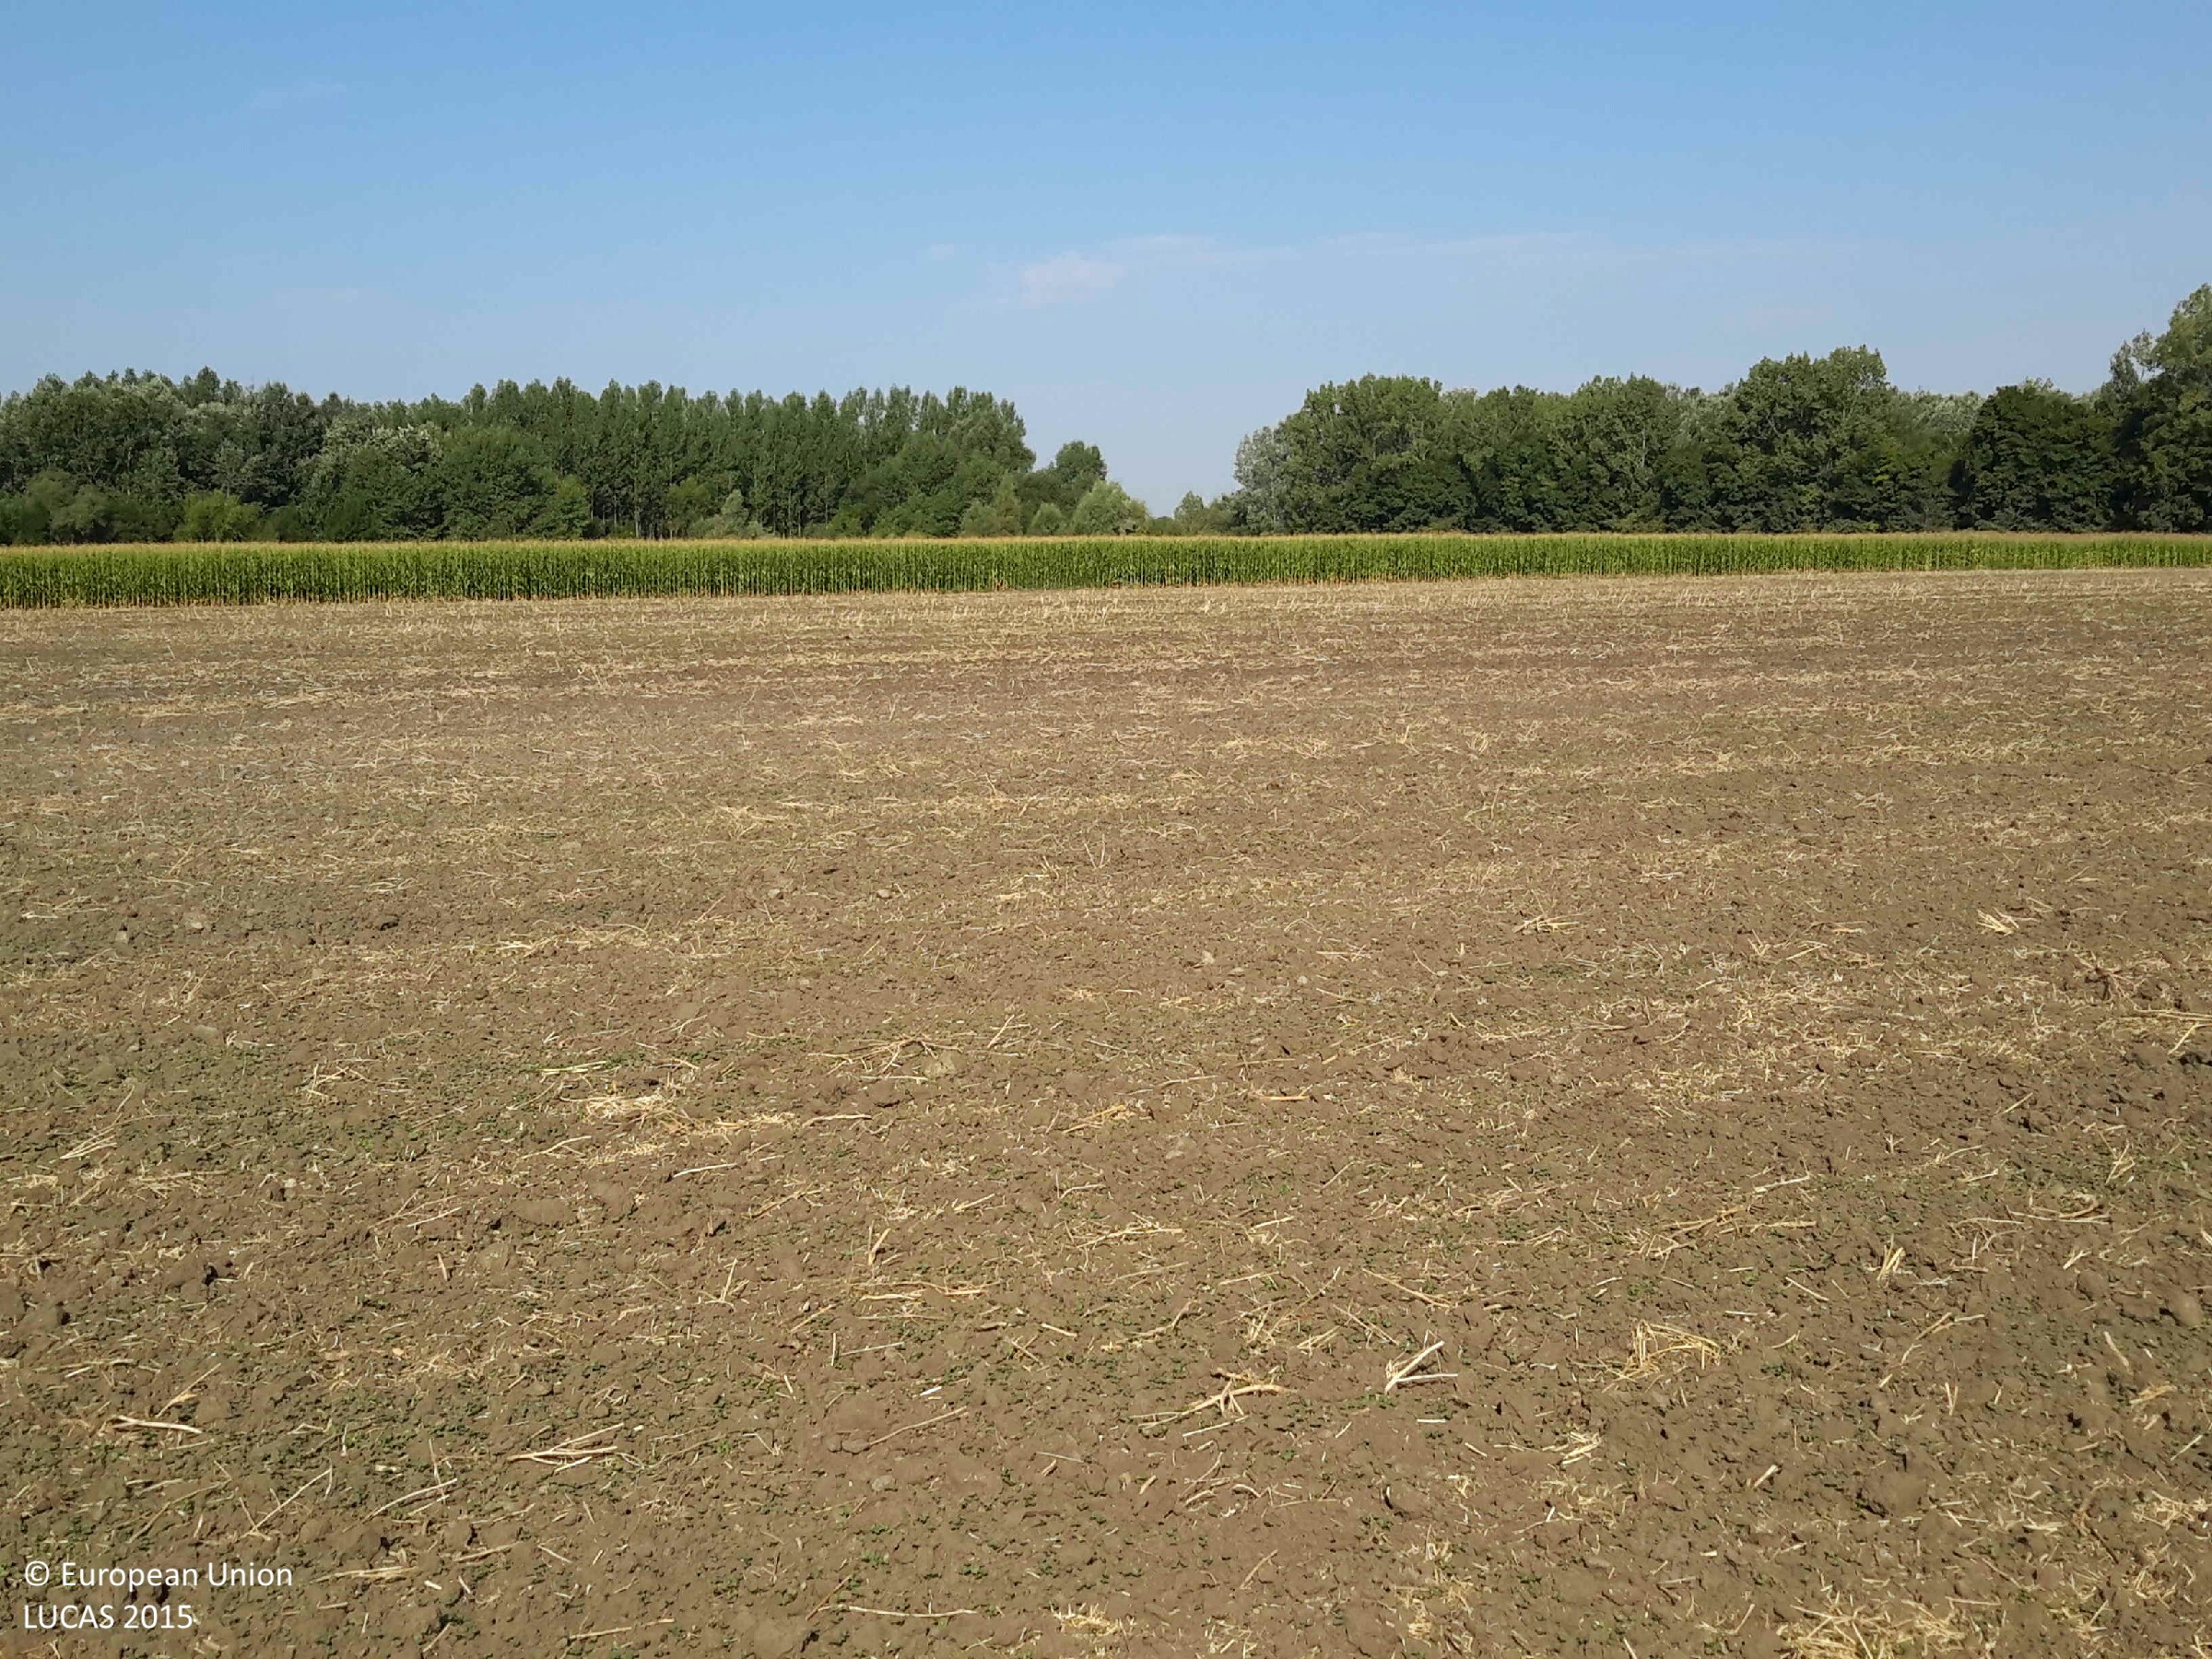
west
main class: Cropland
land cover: Rape and turnip rape
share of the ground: < 10 %
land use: Agriculture (excluding fallow land and kitchen gardens)
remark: Harvested field
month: July
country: HU
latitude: 47.5268
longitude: 17.8597
